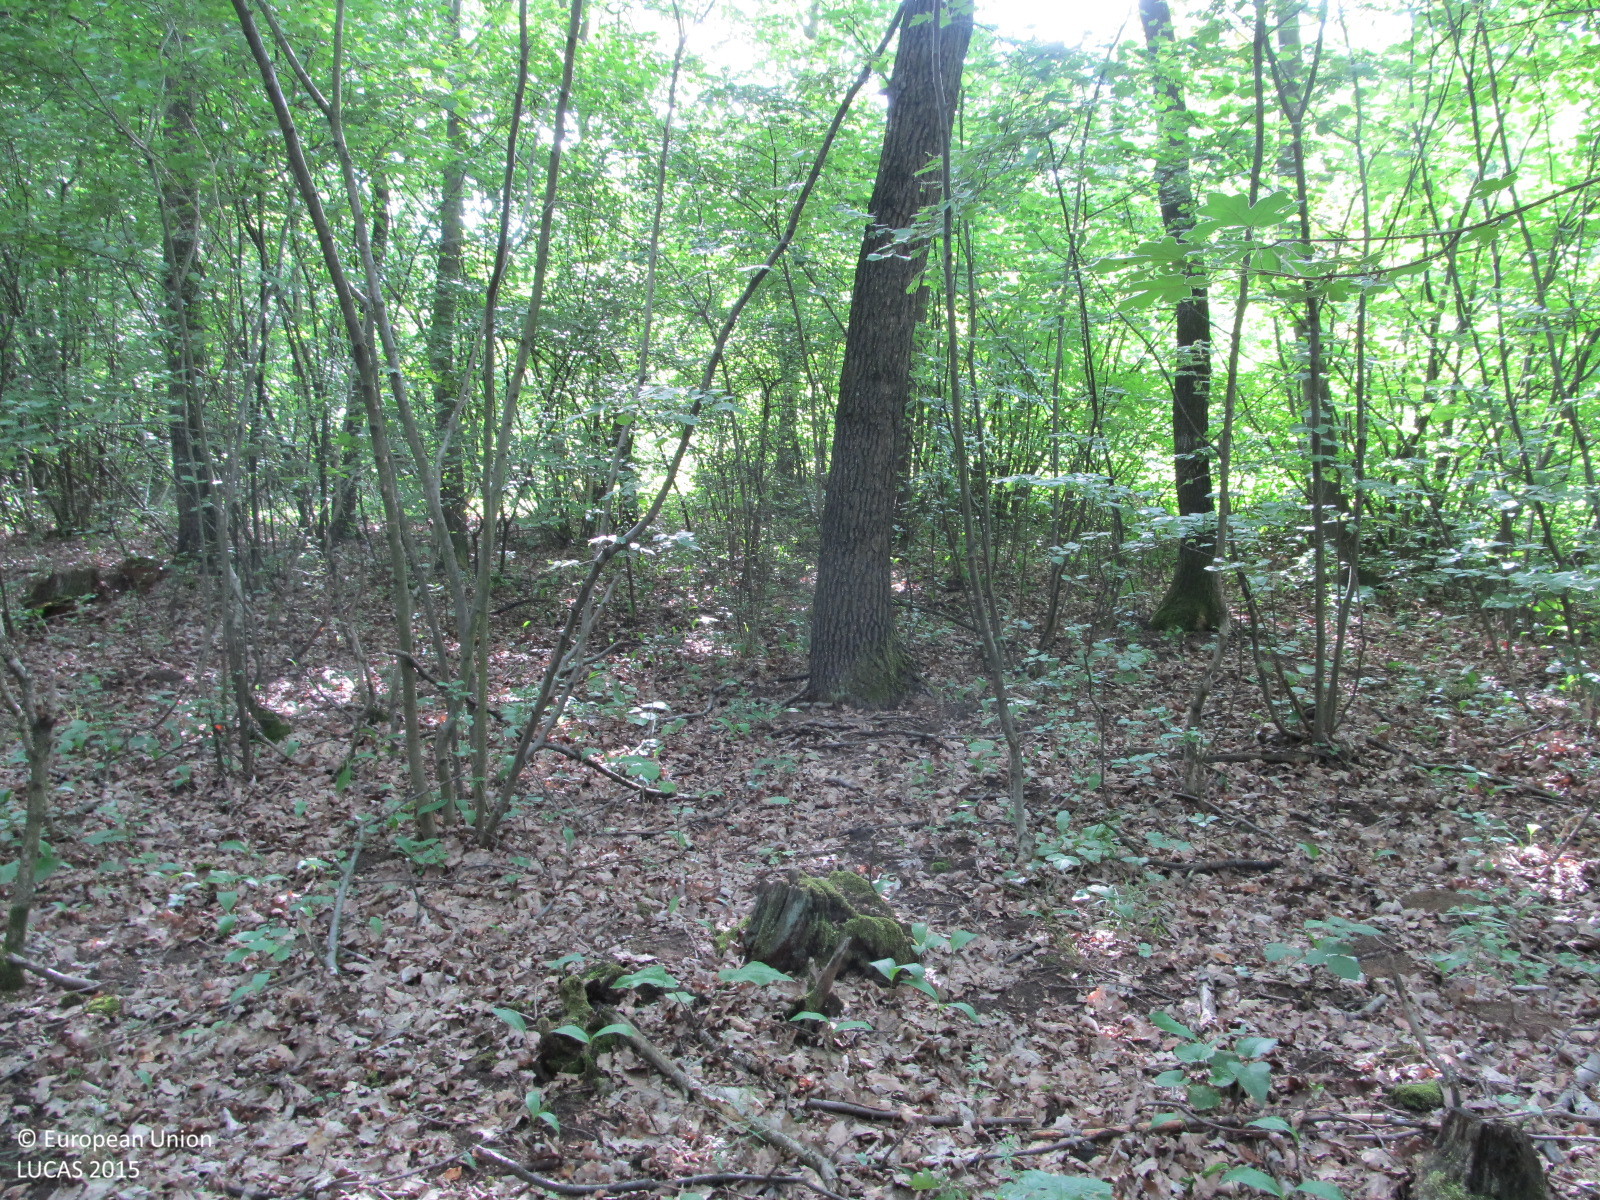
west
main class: Woodland
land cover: Broadleaved woodland
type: mesophytic deciduous forest
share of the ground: > 75 %
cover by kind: broadleaved forest trees 80 %, unconsolidated bare surface 10 %, shrubs 5 %, herbaceous plants 5 %
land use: Forestry
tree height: > 5 m
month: June
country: AT
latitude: 48.6650
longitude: 16.1558
